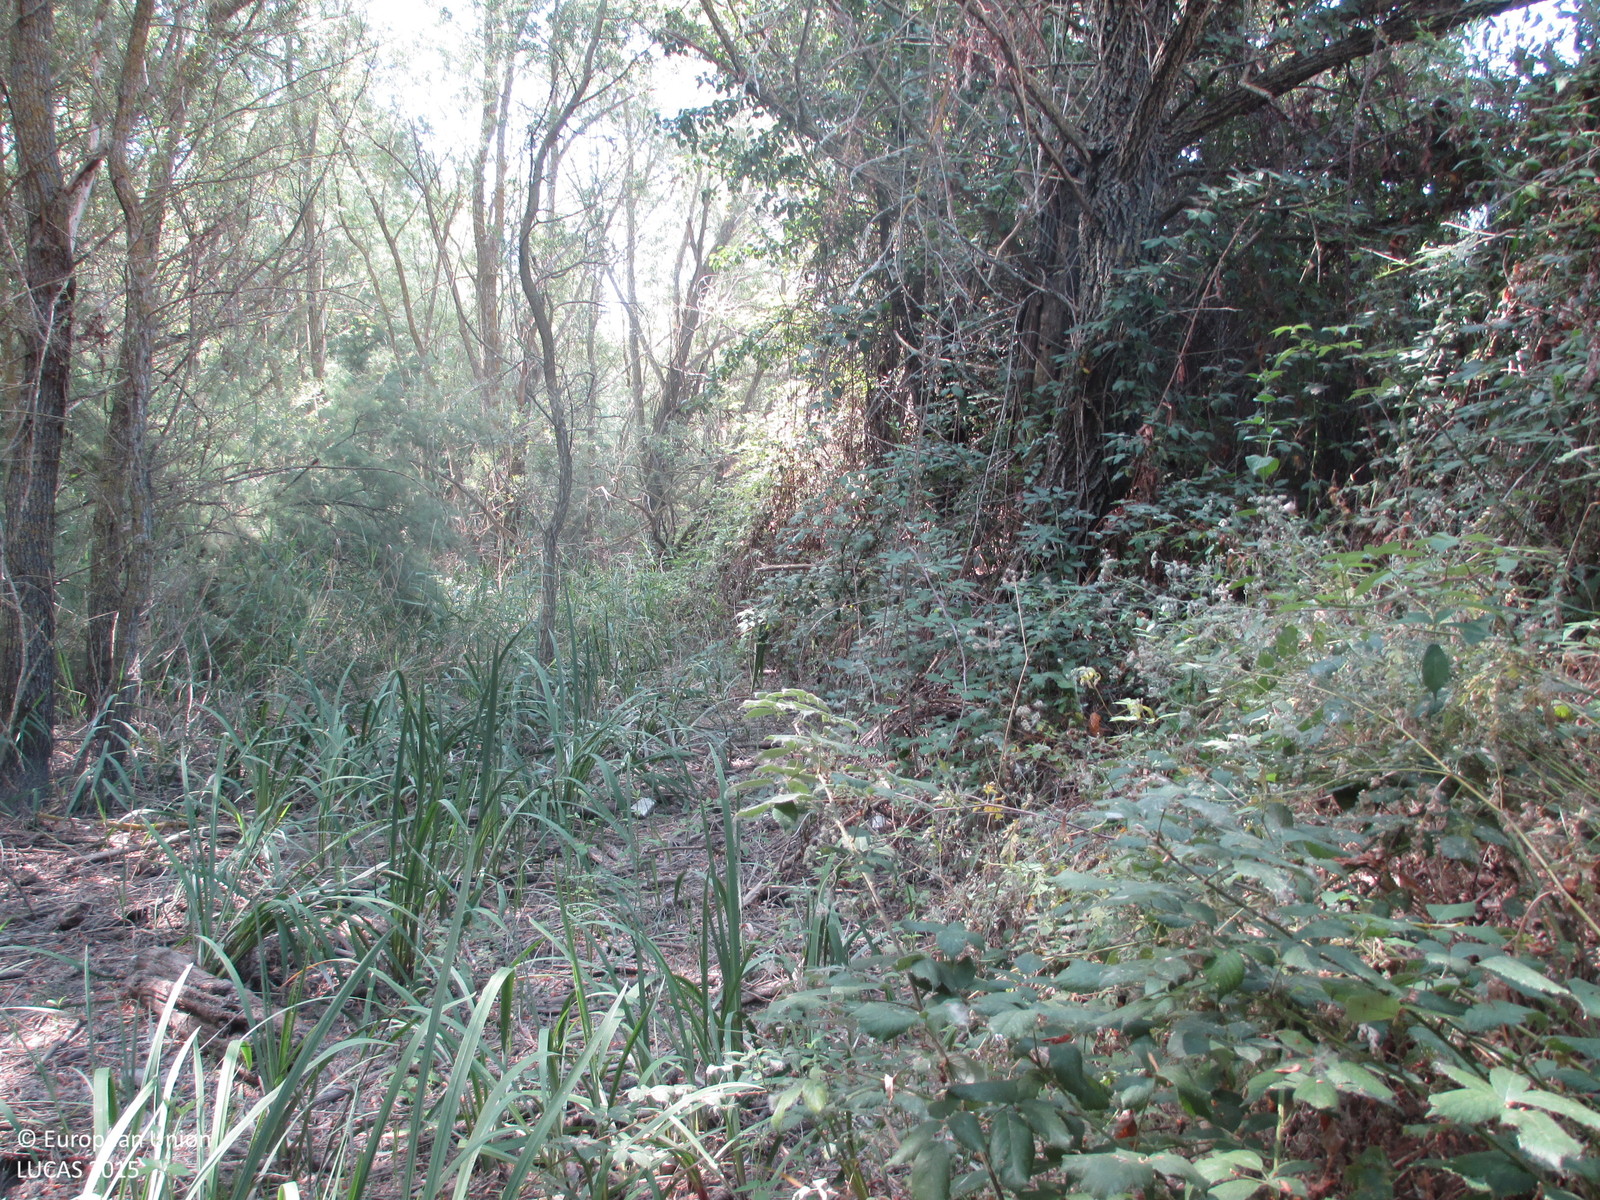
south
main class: Woodland
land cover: Broadleaved woodland
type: floodplain forest
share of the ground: > 75 %
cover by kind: broadleaved forest trees 100 %
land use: Semi-natural and natural areas not in use
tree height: > 5 m
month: July
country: ES
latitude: 42.1725
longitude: 0.3337
